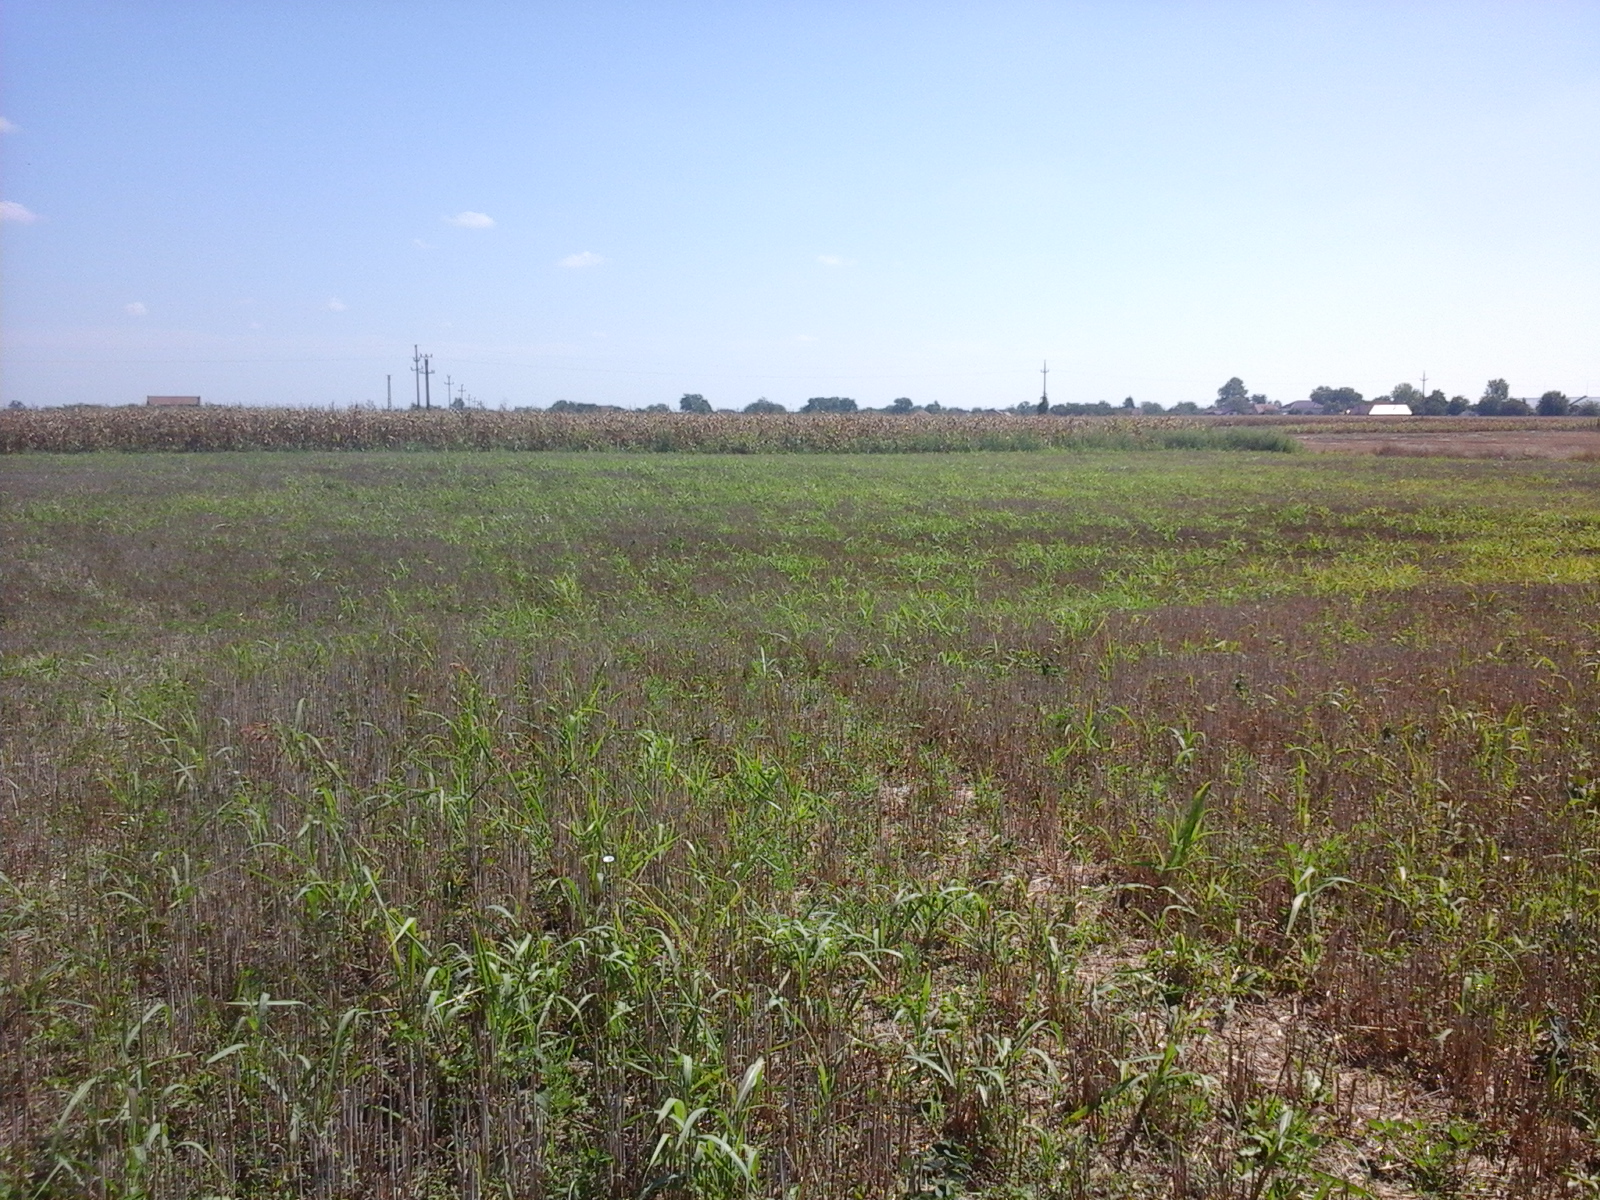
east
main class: Cropland
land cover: Common wheat
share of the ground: > 75 %
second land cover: Spontaneously vegetated surfaces
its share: > 75 %
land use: Agriculture (excluding fallow land and kitchen gardens)
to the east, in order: Common wheat; Spontaneously vegetated surfaces; Maize; Common wheat; Electric lines; Common wheat; Tracks; Grass margins; Maize
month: August
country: RO
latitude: 46.1050
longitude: 21.0396
